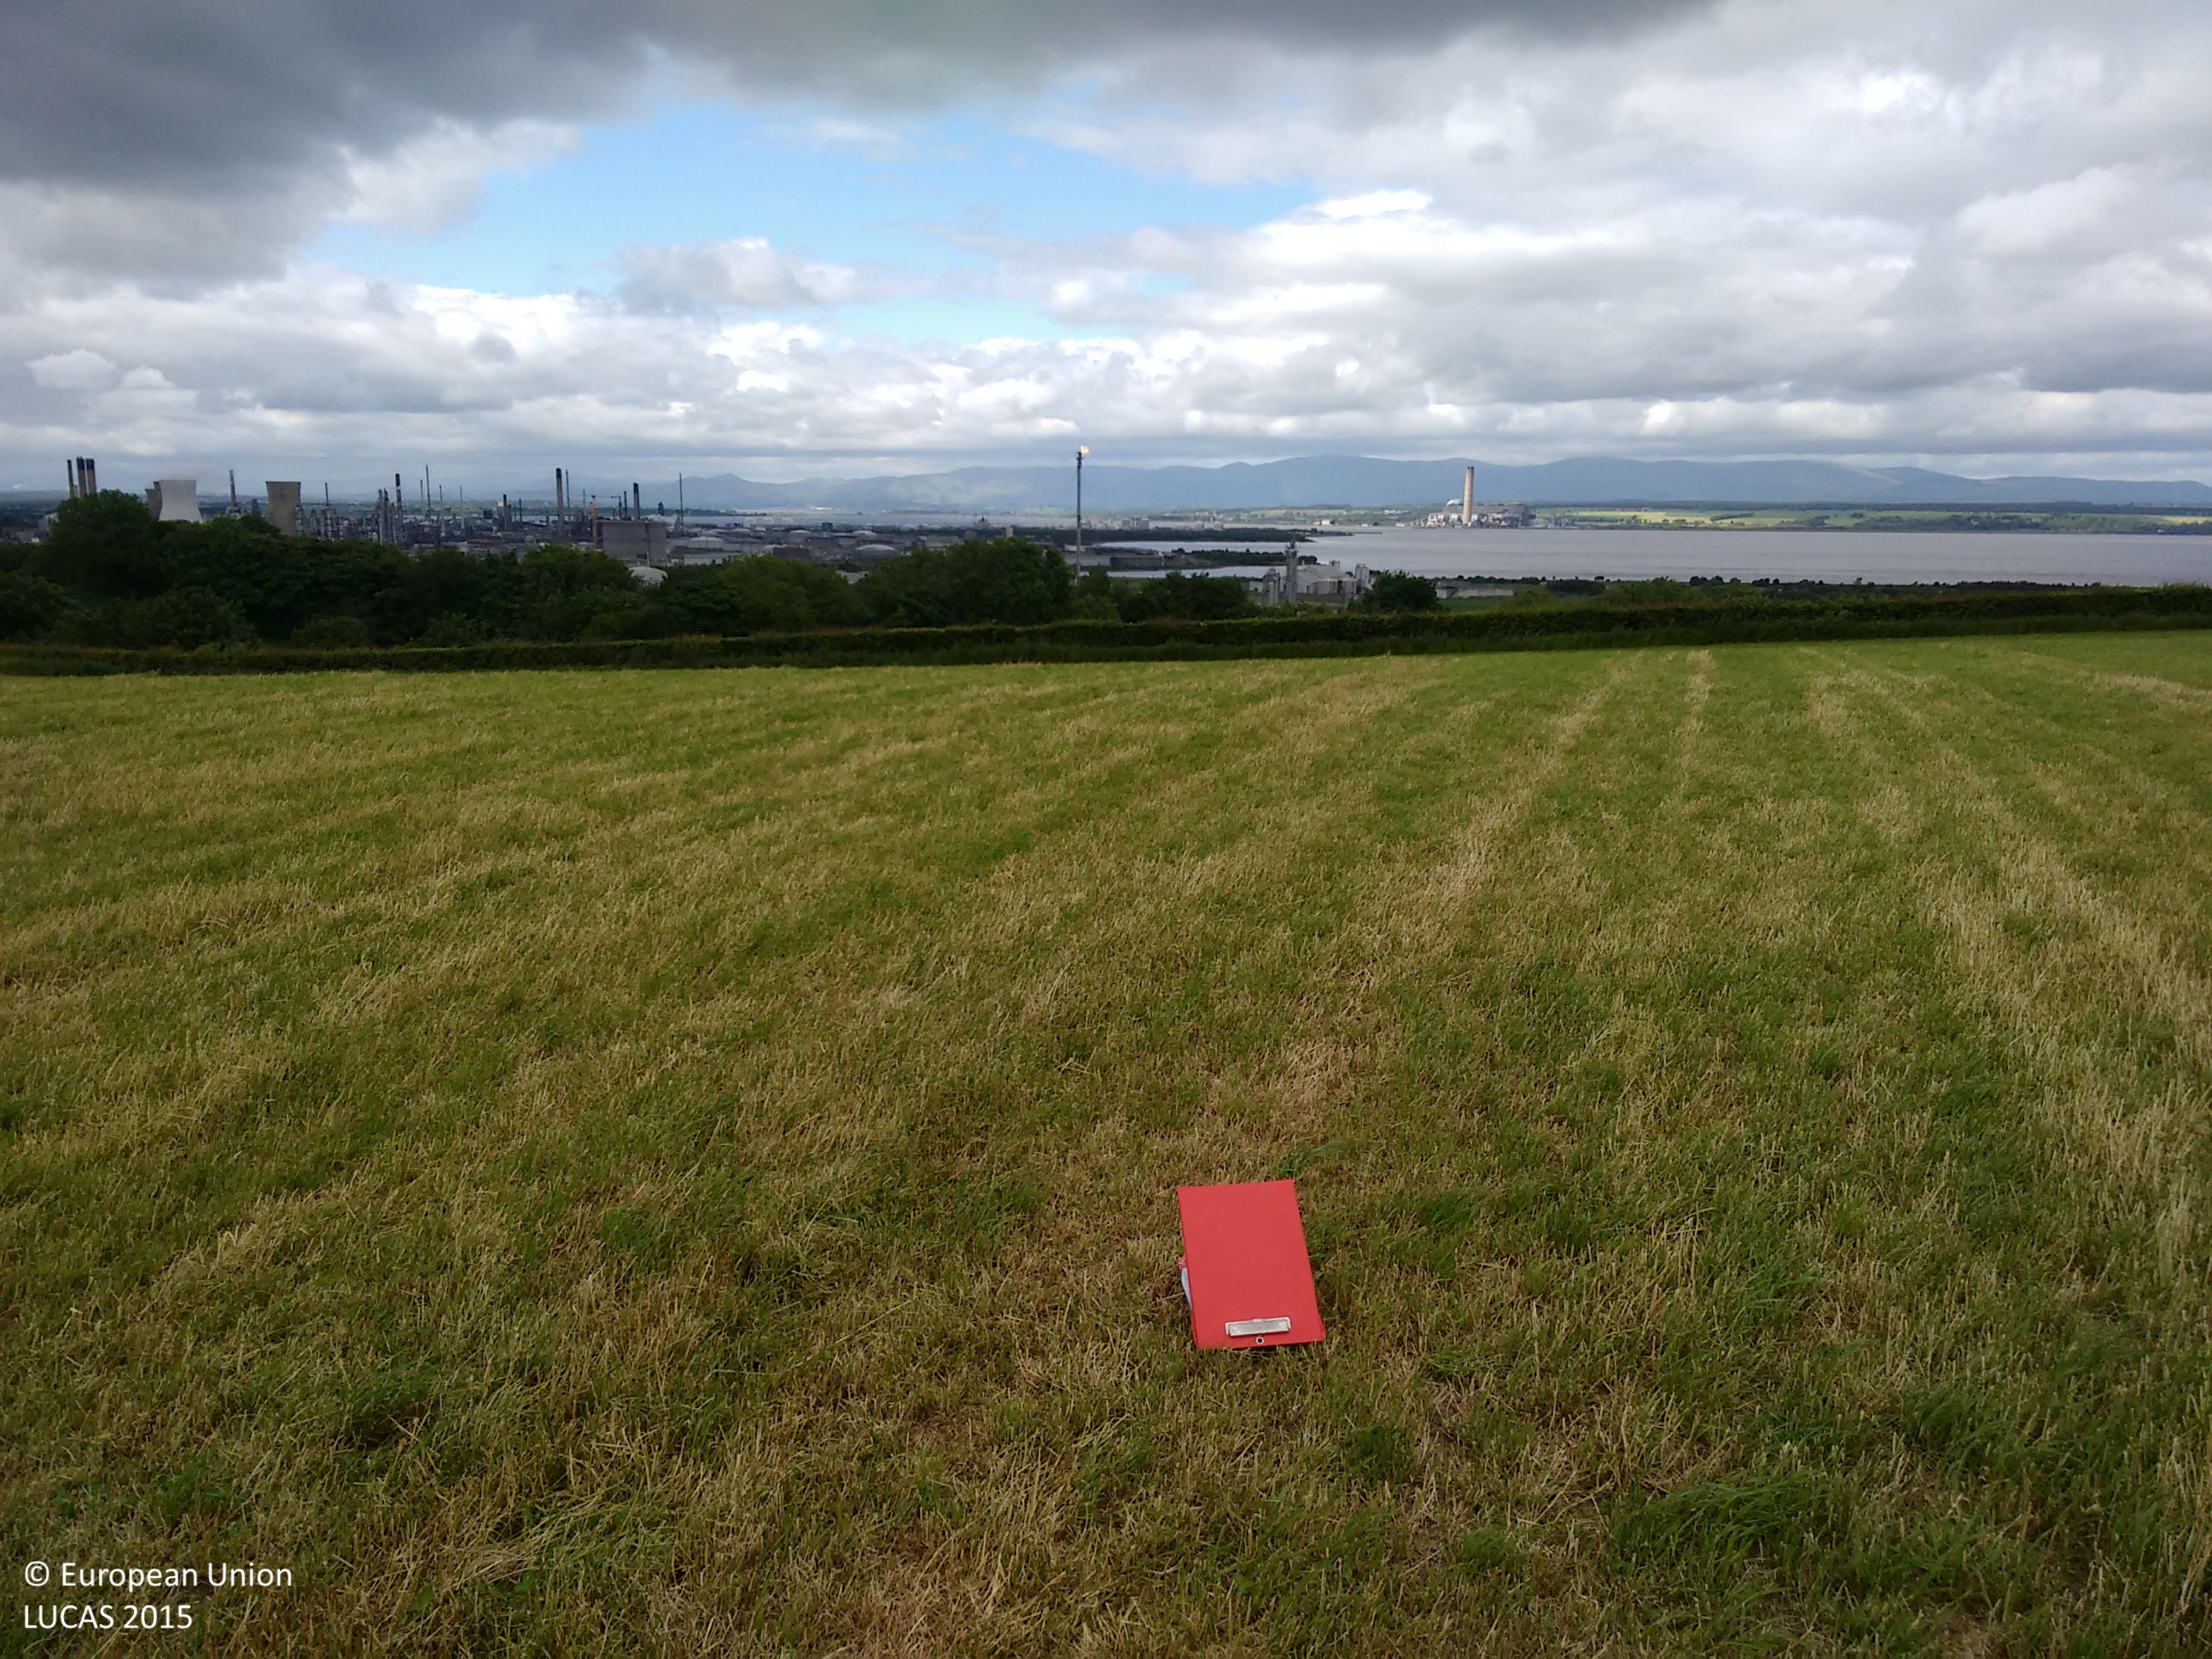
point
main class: Grassland
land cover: Grassland without tree/shrub cover
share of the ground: > 75 %
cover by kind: herbaceous plants 100 %
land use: Agriculture (excluding fallow land and kitchen gardens)
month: June
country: GB
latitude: 56.0004
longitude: -3.6619
